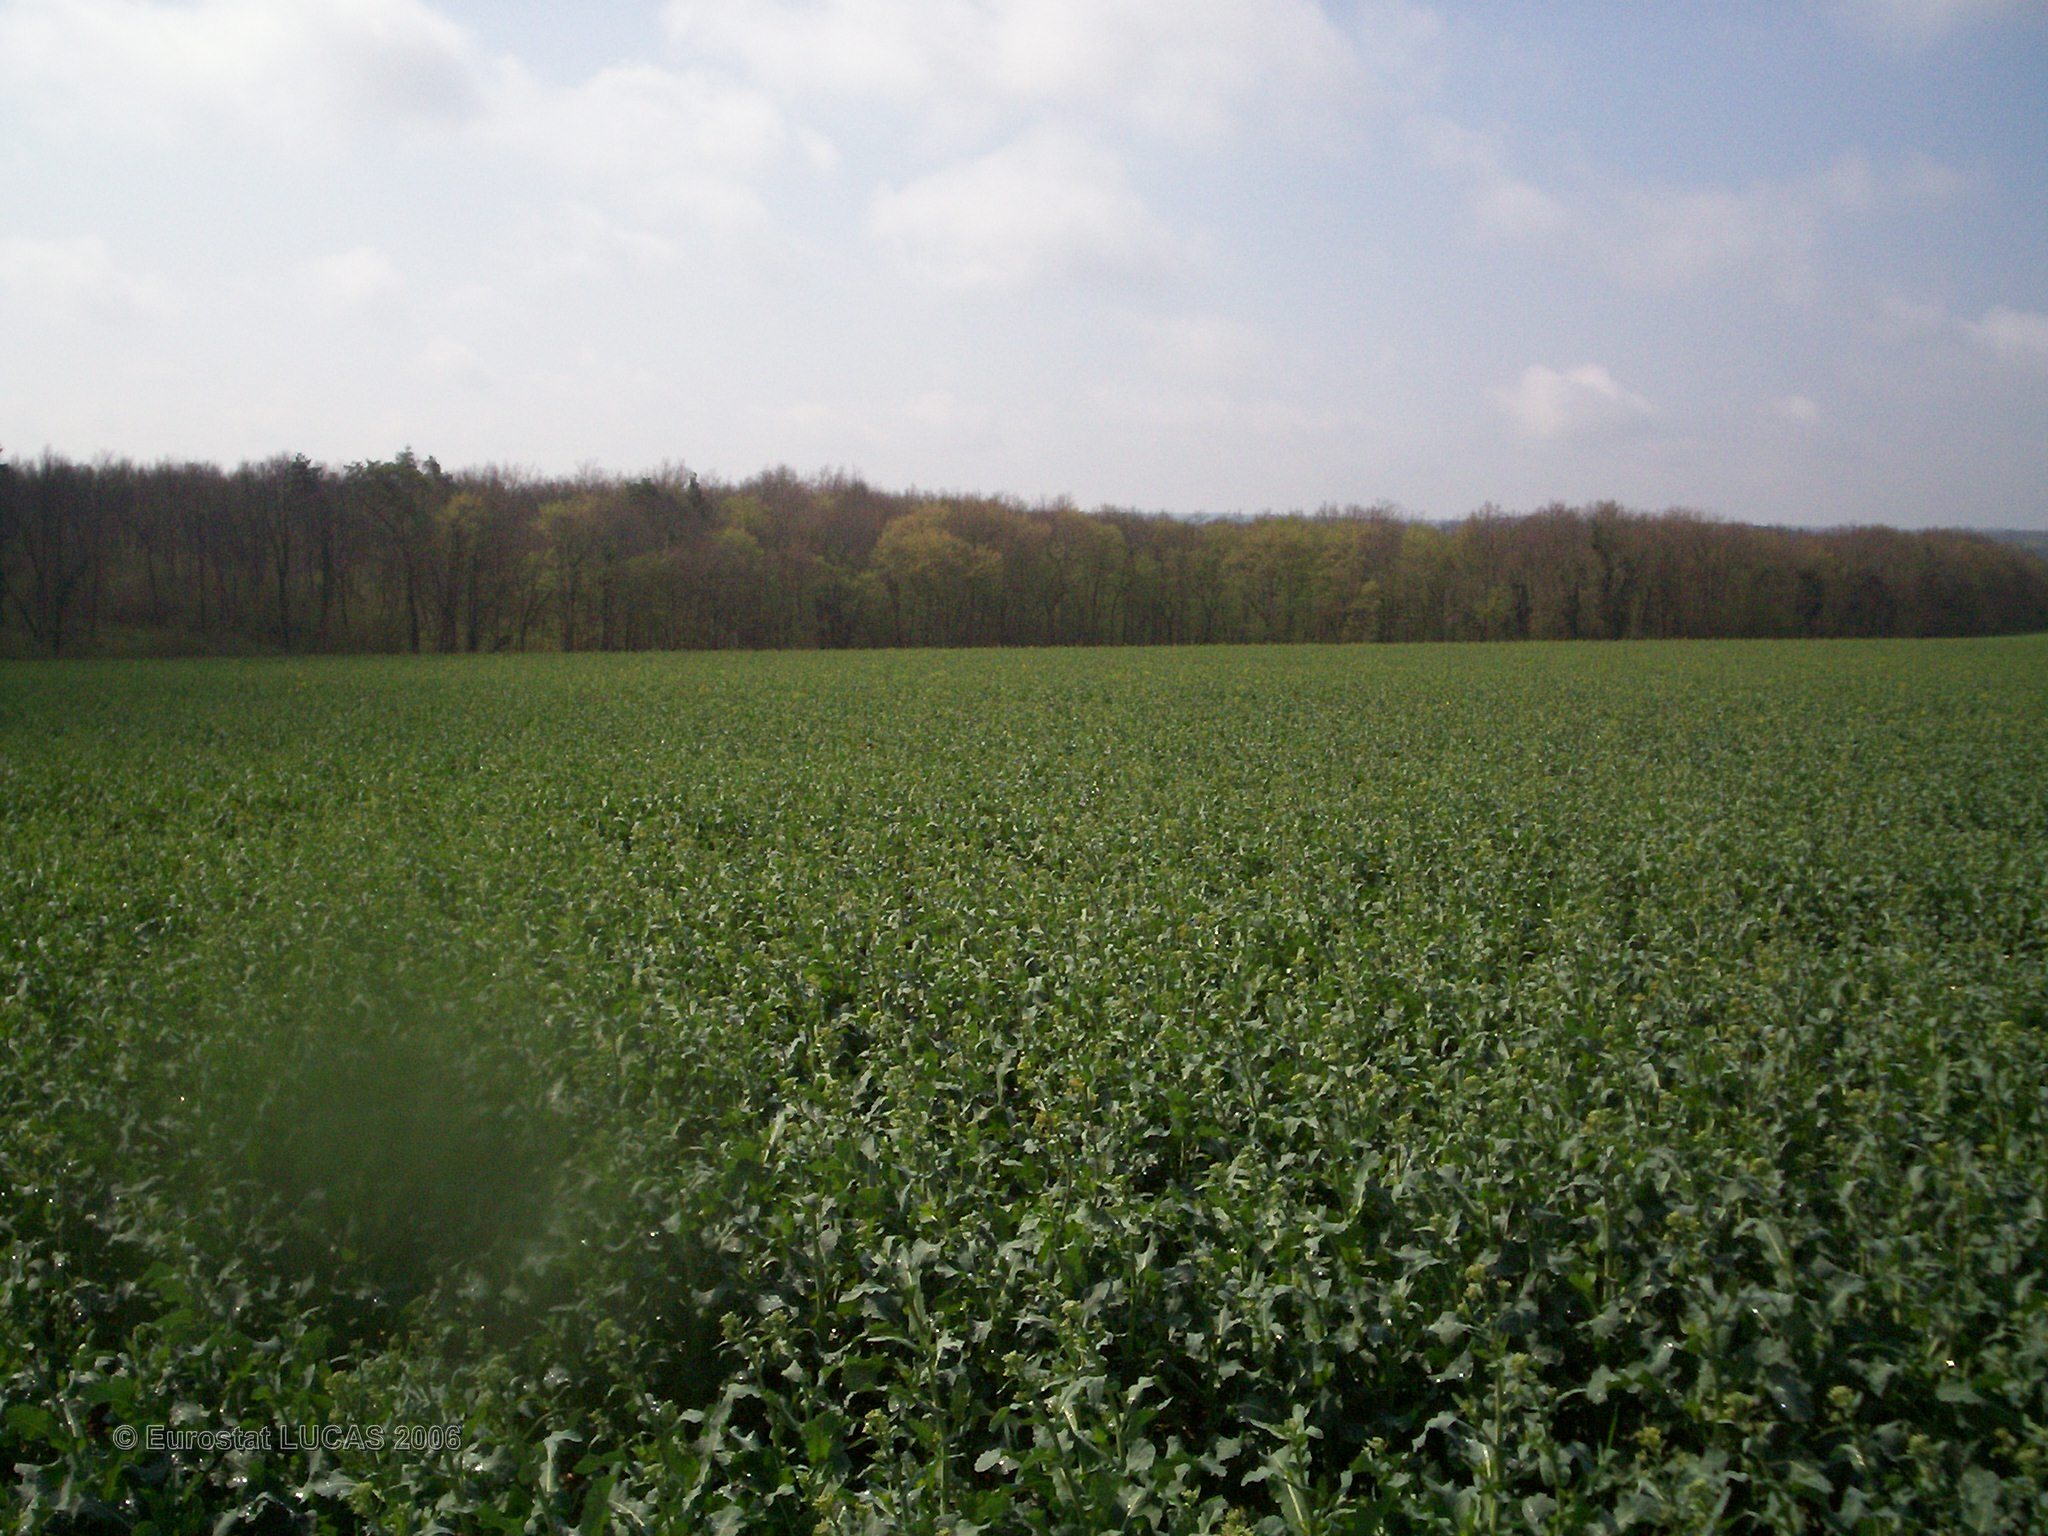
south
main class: Cropland
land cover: Rape and turnip rape
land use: Agriculture (excluding fallow land and kitchen gardens)
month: April
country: FR
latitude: 47.7449
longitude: 3.8483
